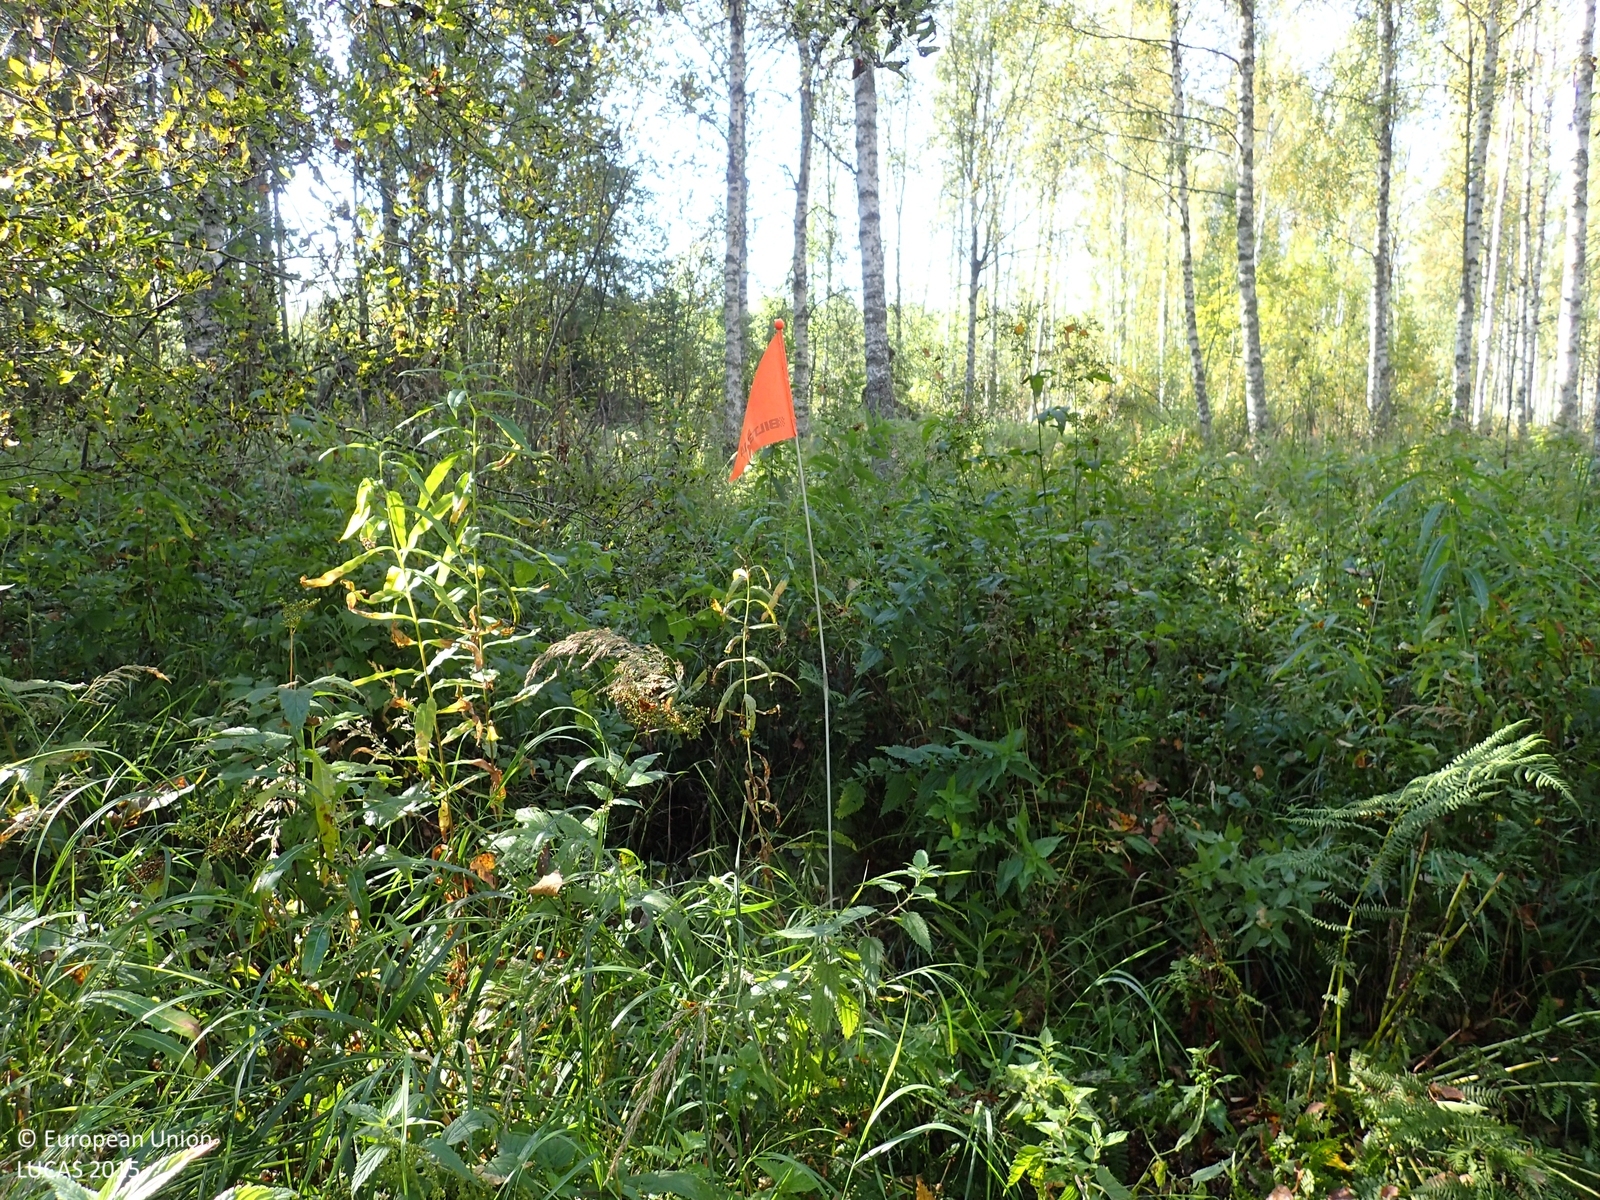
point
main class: Woodland
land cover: Broadleaved woodland
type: non-riverine alder, birch or aspen forest
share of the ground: 50 - 75 %
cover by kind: broadleaved forest trees 70 %, herbaceous plants 30 %
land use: Forestry
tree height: > 5 m
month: September
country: FI
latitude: 63.1915
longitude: 25.6293
